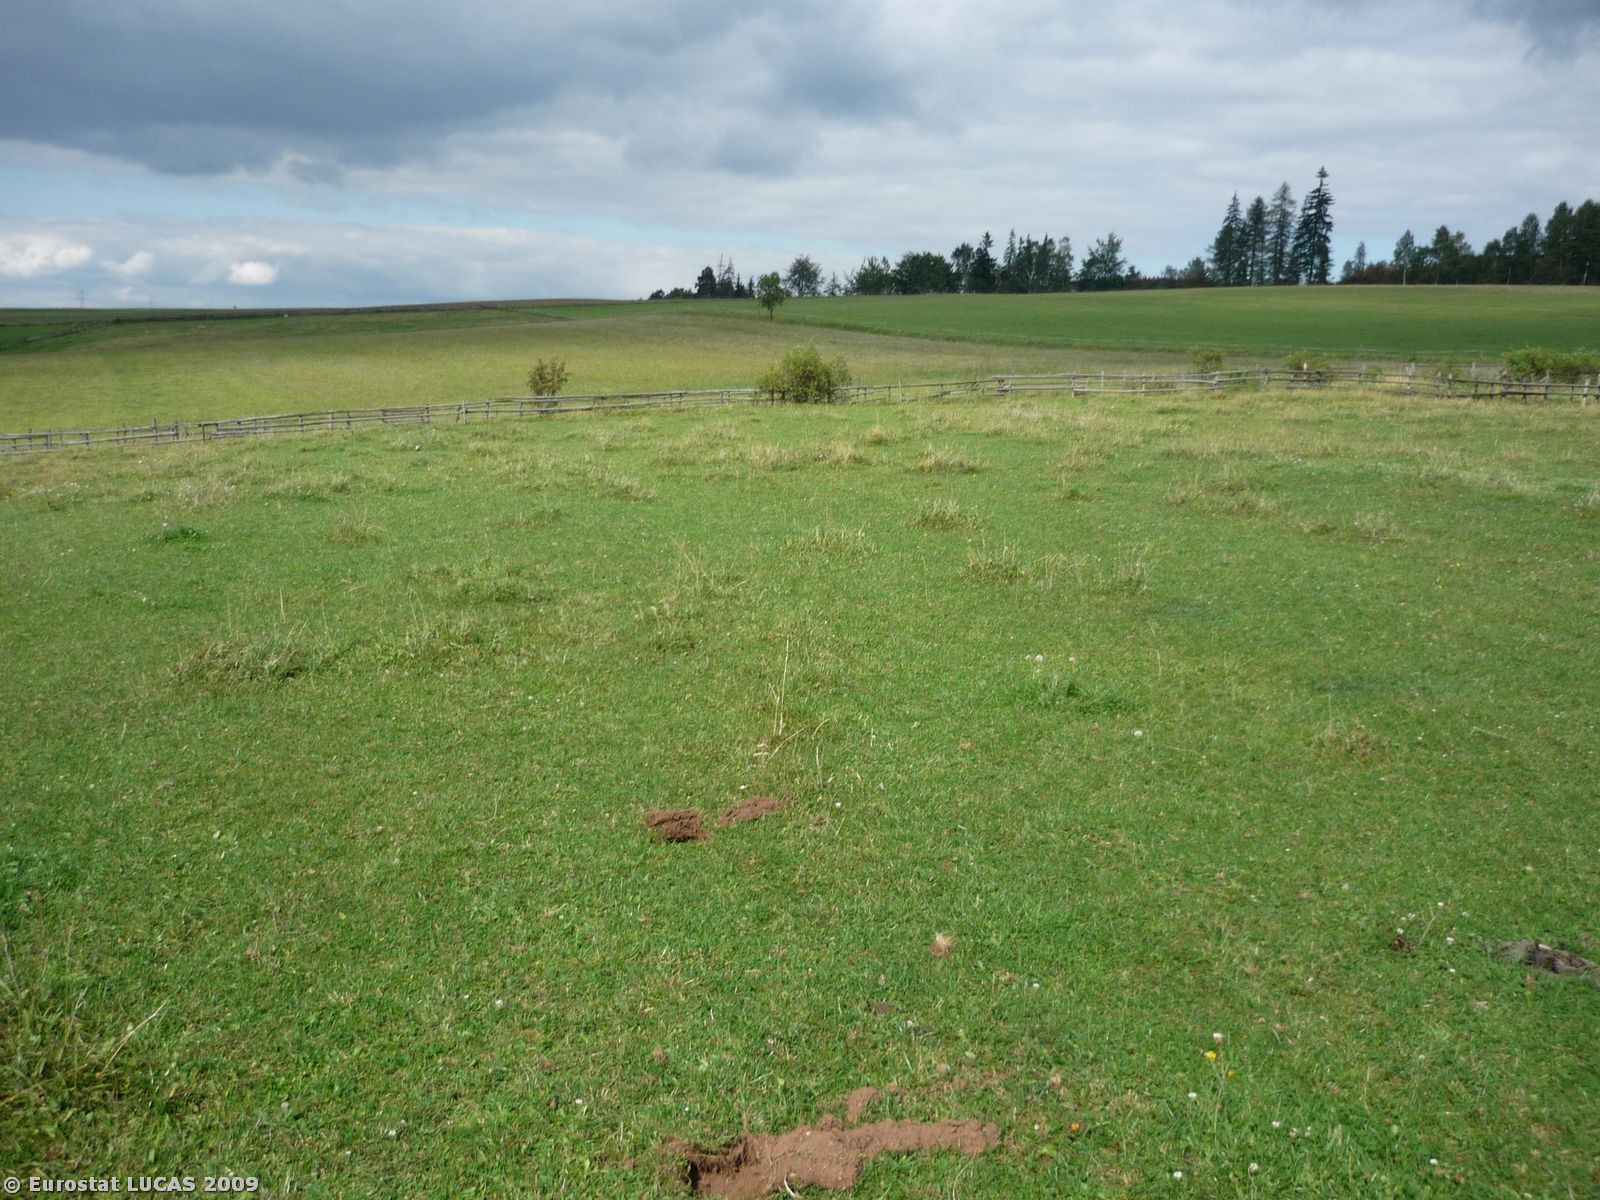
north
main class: Grassland
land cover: Grassland without tree/shrub cover
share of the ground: > 75 %
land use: Agriculture (excluding fallow land and kitchen gardens)
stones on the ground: 10 - 25 %
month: September
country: PL
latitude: 50.6848
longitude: 16.1633
